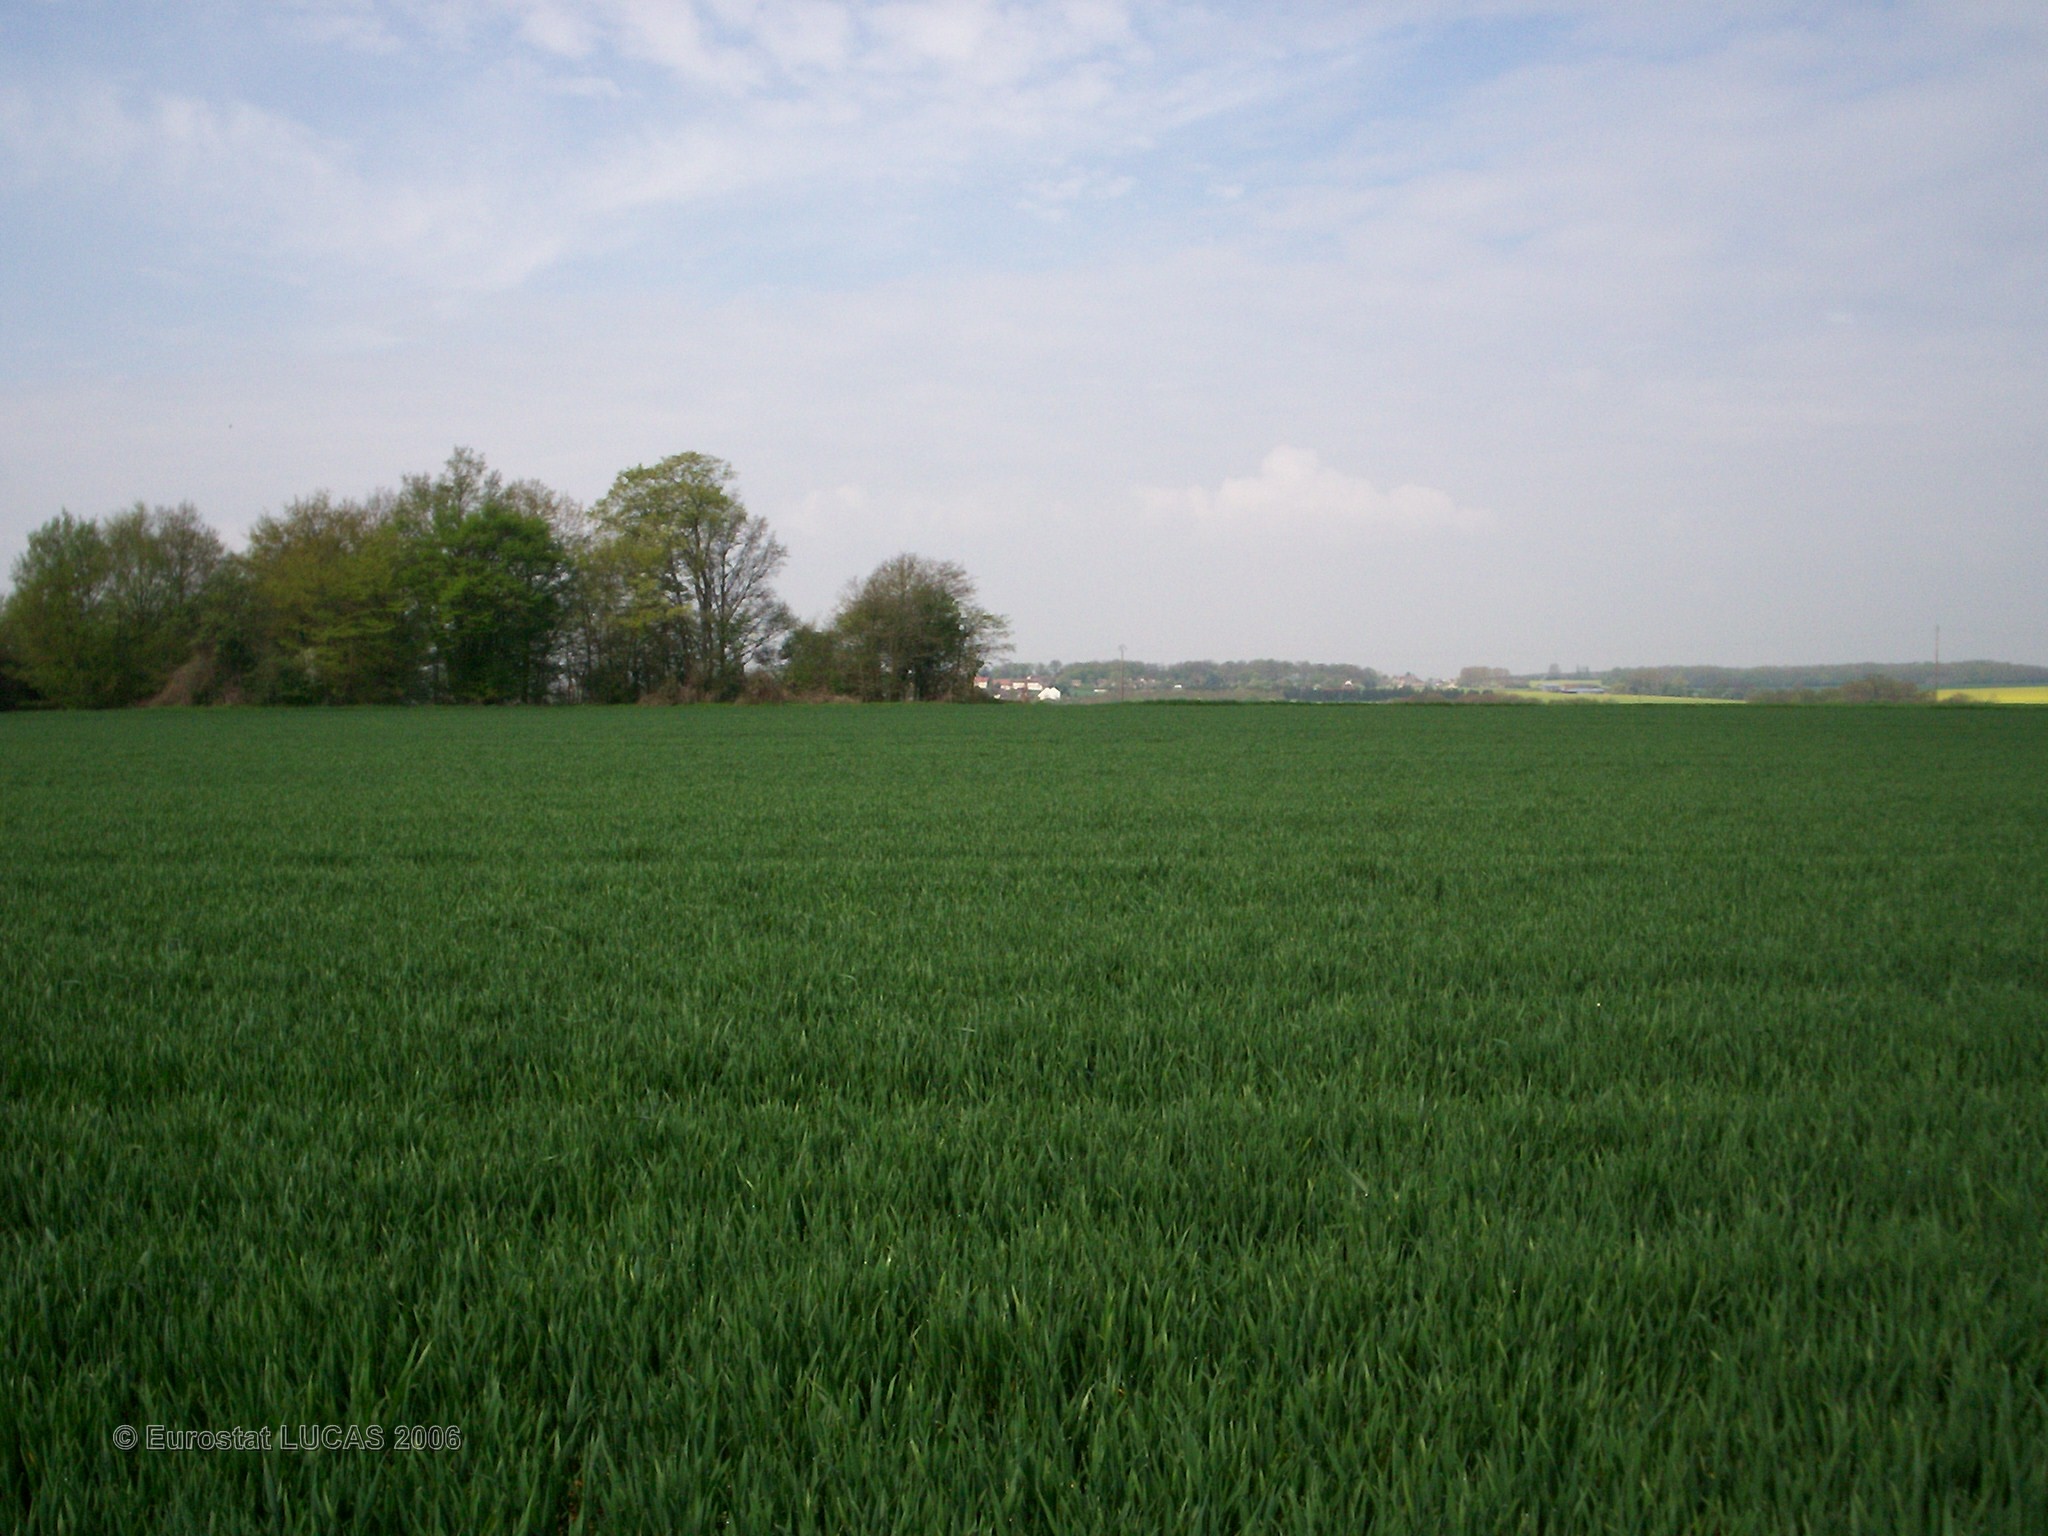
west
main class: Cropland
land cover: Common wheat
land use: Agriculture (excluding fallow land and kitchen gardens)
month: April
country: FR
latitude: 47.8532
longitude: 2.9498
